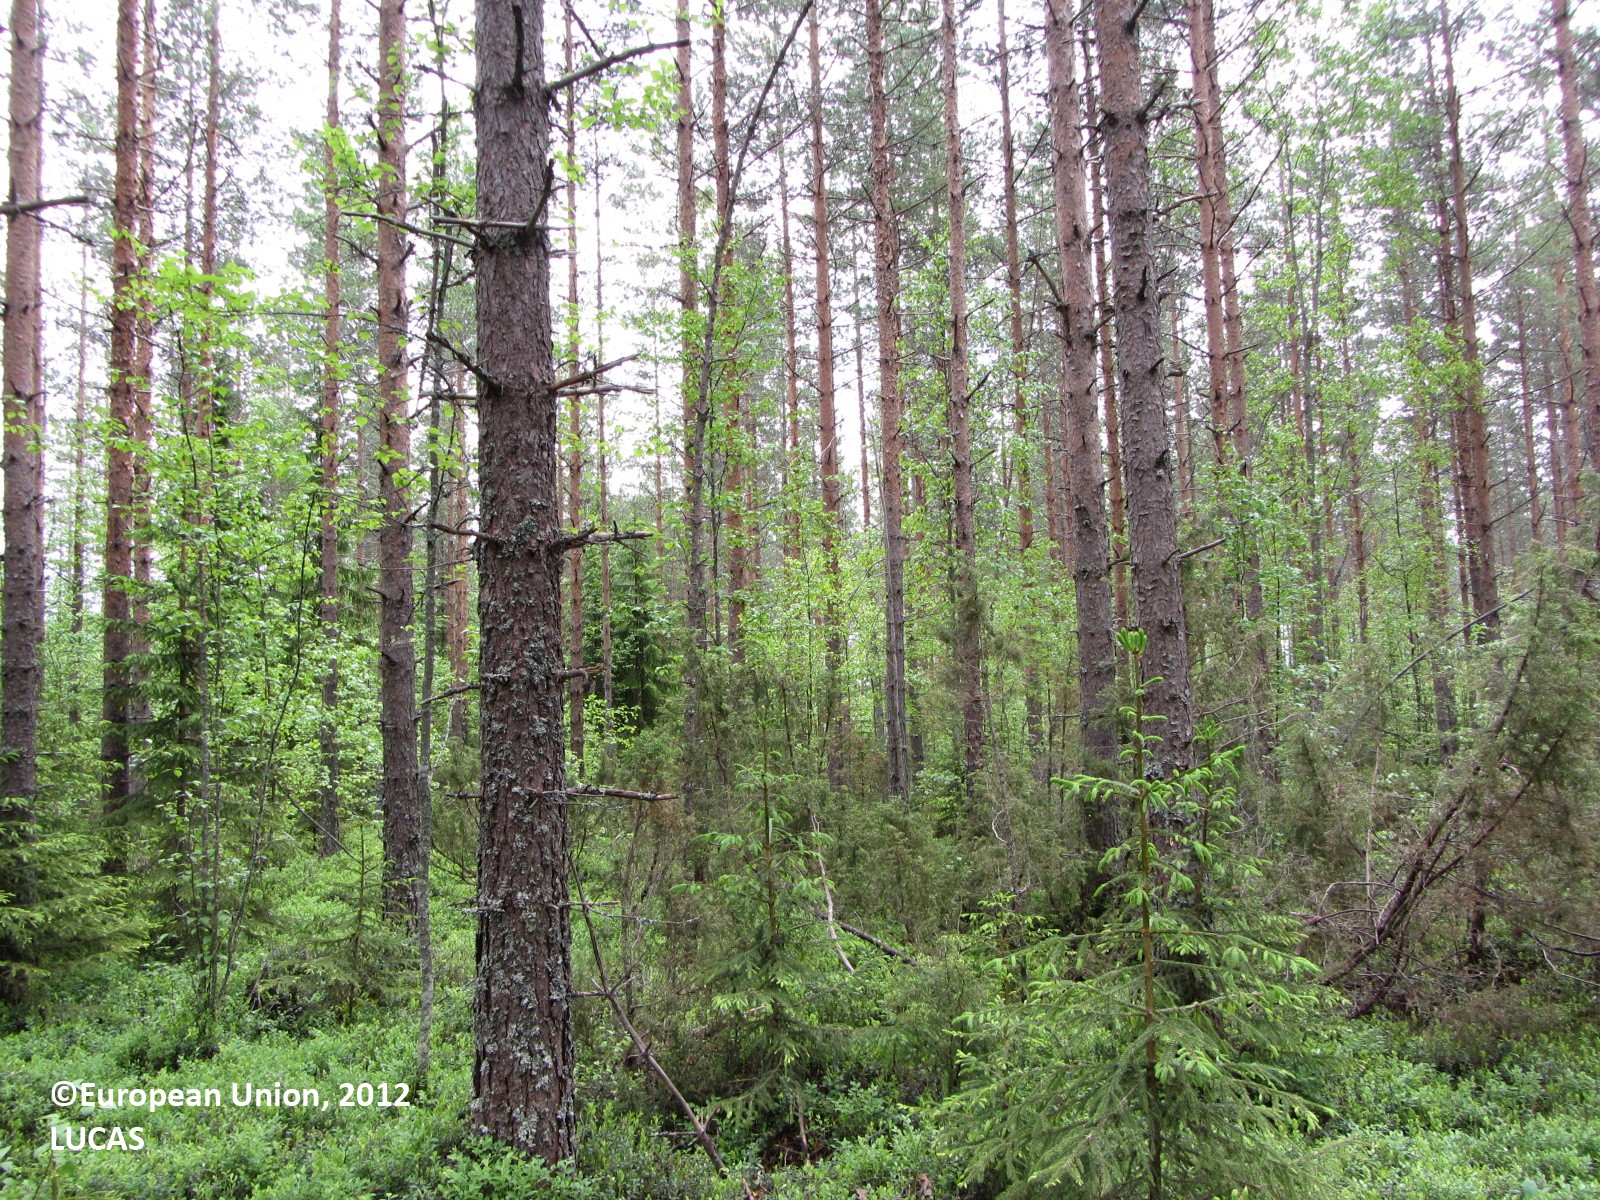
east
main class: Woodland
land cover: Pine dominated coniferous woodland
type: boreal forest
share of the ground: 50 - 75 %
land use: Forestry
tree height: > 5 m
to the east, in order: Pine dominated coniferous woodland; Pine dominated mixed woodland; Spruce dominated coniferous woodland; Shrubland without tree cover; Spruce dominated coniferous woodland; Ditches and canals; Spruce dominated coniferous woodland; Ditches and canals; Spruce dominated coniferous woodland; Shrubland with sparse tree cover; Ditches and canals; Spruce dominated coniferous woodland; Managed hedges; Ditches and canals; Abandoned hedges; Paved roads, cycling and walking lanes; Abandoned hedges; Ditches and canals; Spruce dominated coniferous woodland; Shrubland without tree cover; Spruce dominated mixed woodland
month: June
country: FI
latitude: 62.4987
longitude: 25.1874
